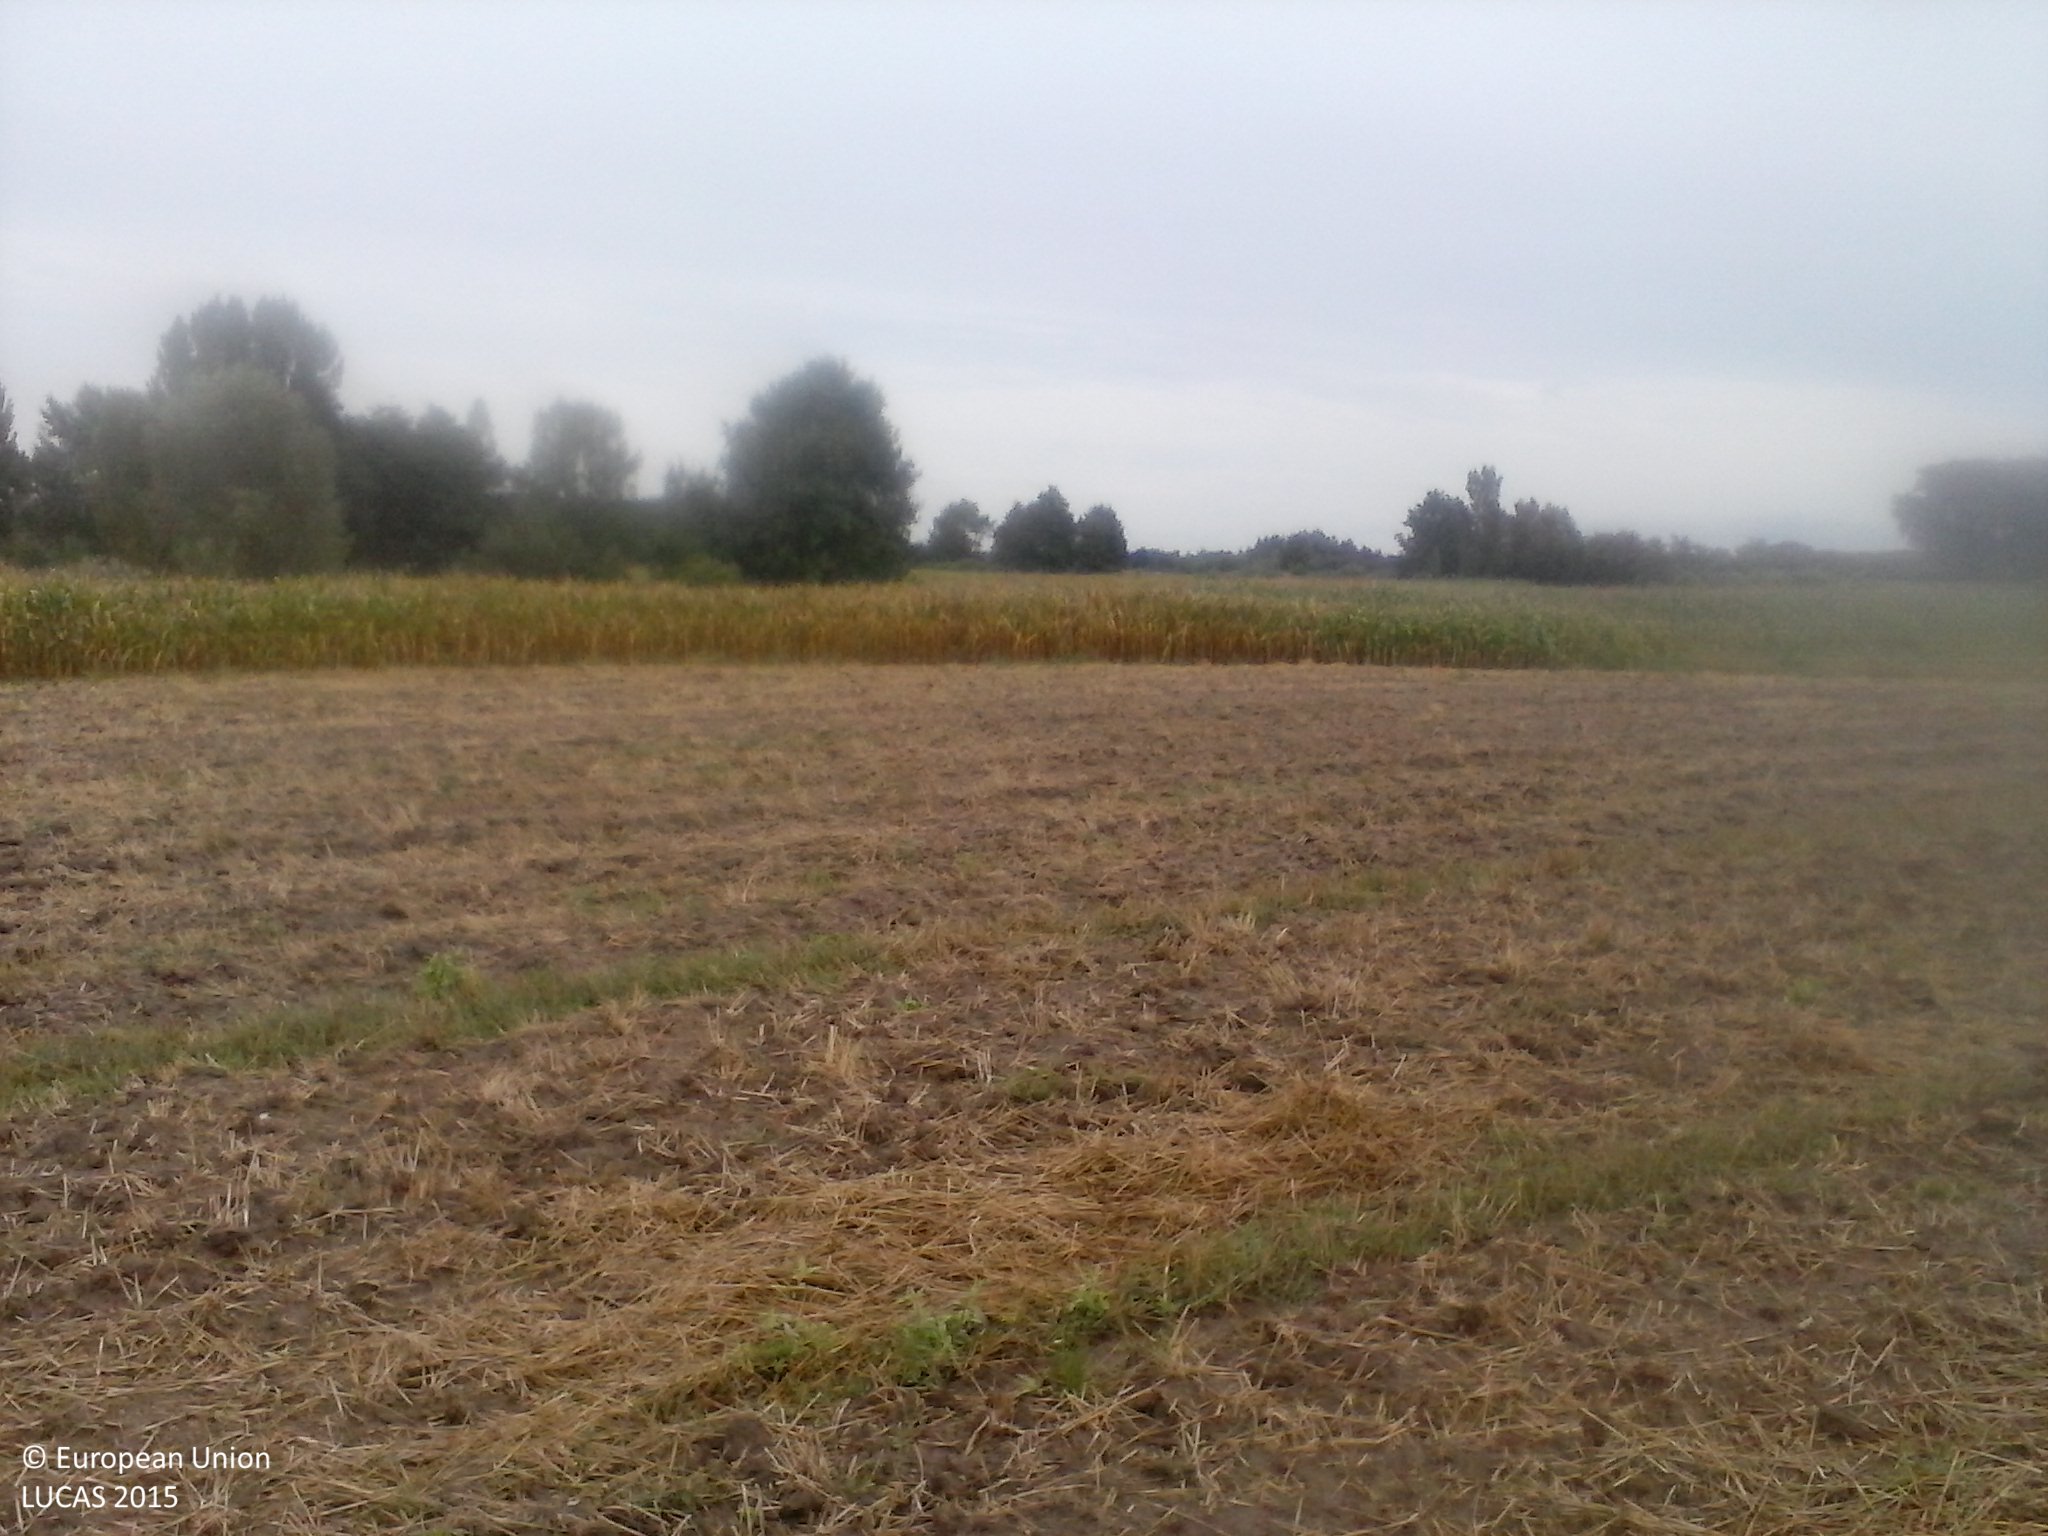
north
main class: Cropland
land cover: Common wheat
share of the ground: < 10 %
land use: Agriculture (excluding fallow land and kitchen gardens)
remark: Harvested field
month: July
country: HU
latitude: 45.9445
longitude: 17.7309
